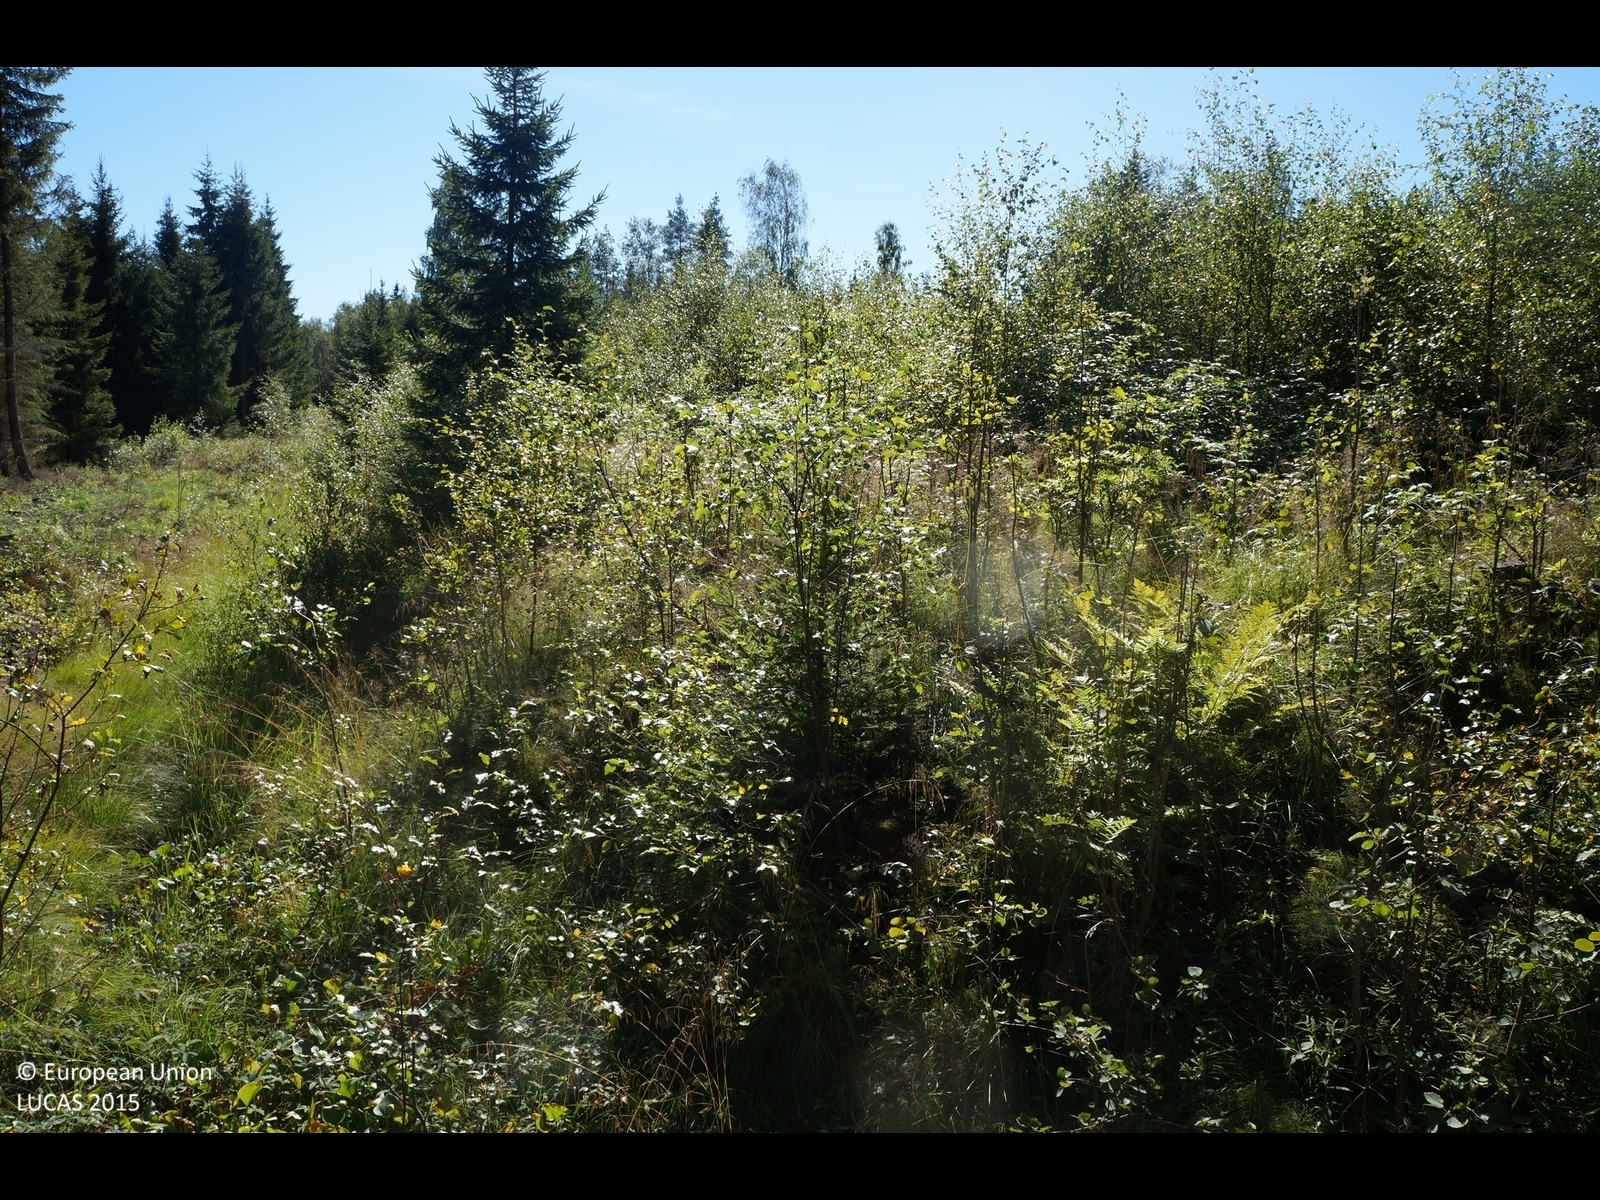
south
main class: Woodland
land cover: Broadleaved woodland
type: boreal forest
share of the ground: 25 - 50 %
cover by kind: herbaceous plants 50 %, broadleaved forest trees 30 %, shrubs 10 %, coniferous forest trees 5 %, lichens and mosses 5 %
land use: Forestry
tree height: > 5 m
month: August
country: FI
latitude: 63.8234
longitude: 22.7874
